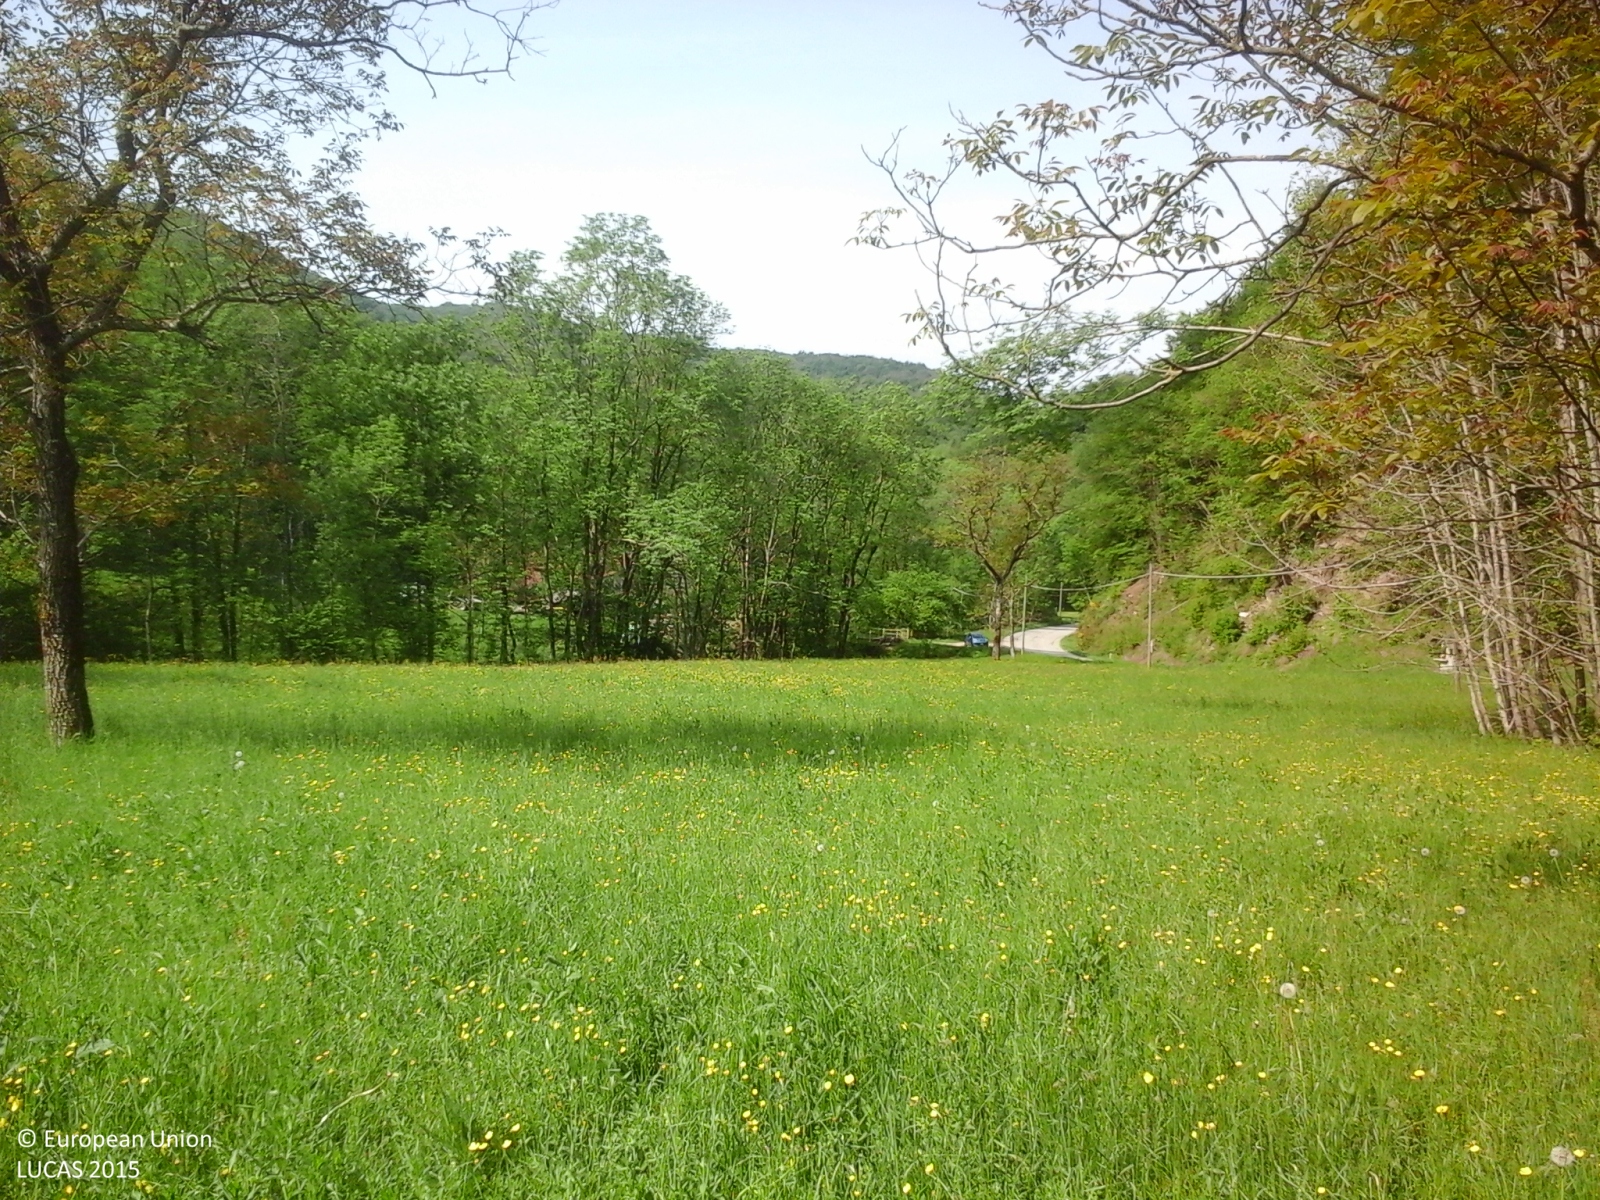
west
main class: Grassland
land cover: Grassland with sparse tree/shrub cover
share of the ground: > 75 %
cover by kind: herbaceous plants 95 %, broadleaved forest trees 5 %
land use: Agriculture (excluding fallow land and kitchen gardens)
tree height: > 5 m
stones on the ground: < 10 %
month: May
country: IT
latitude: 45.8177
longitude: 8.4707
